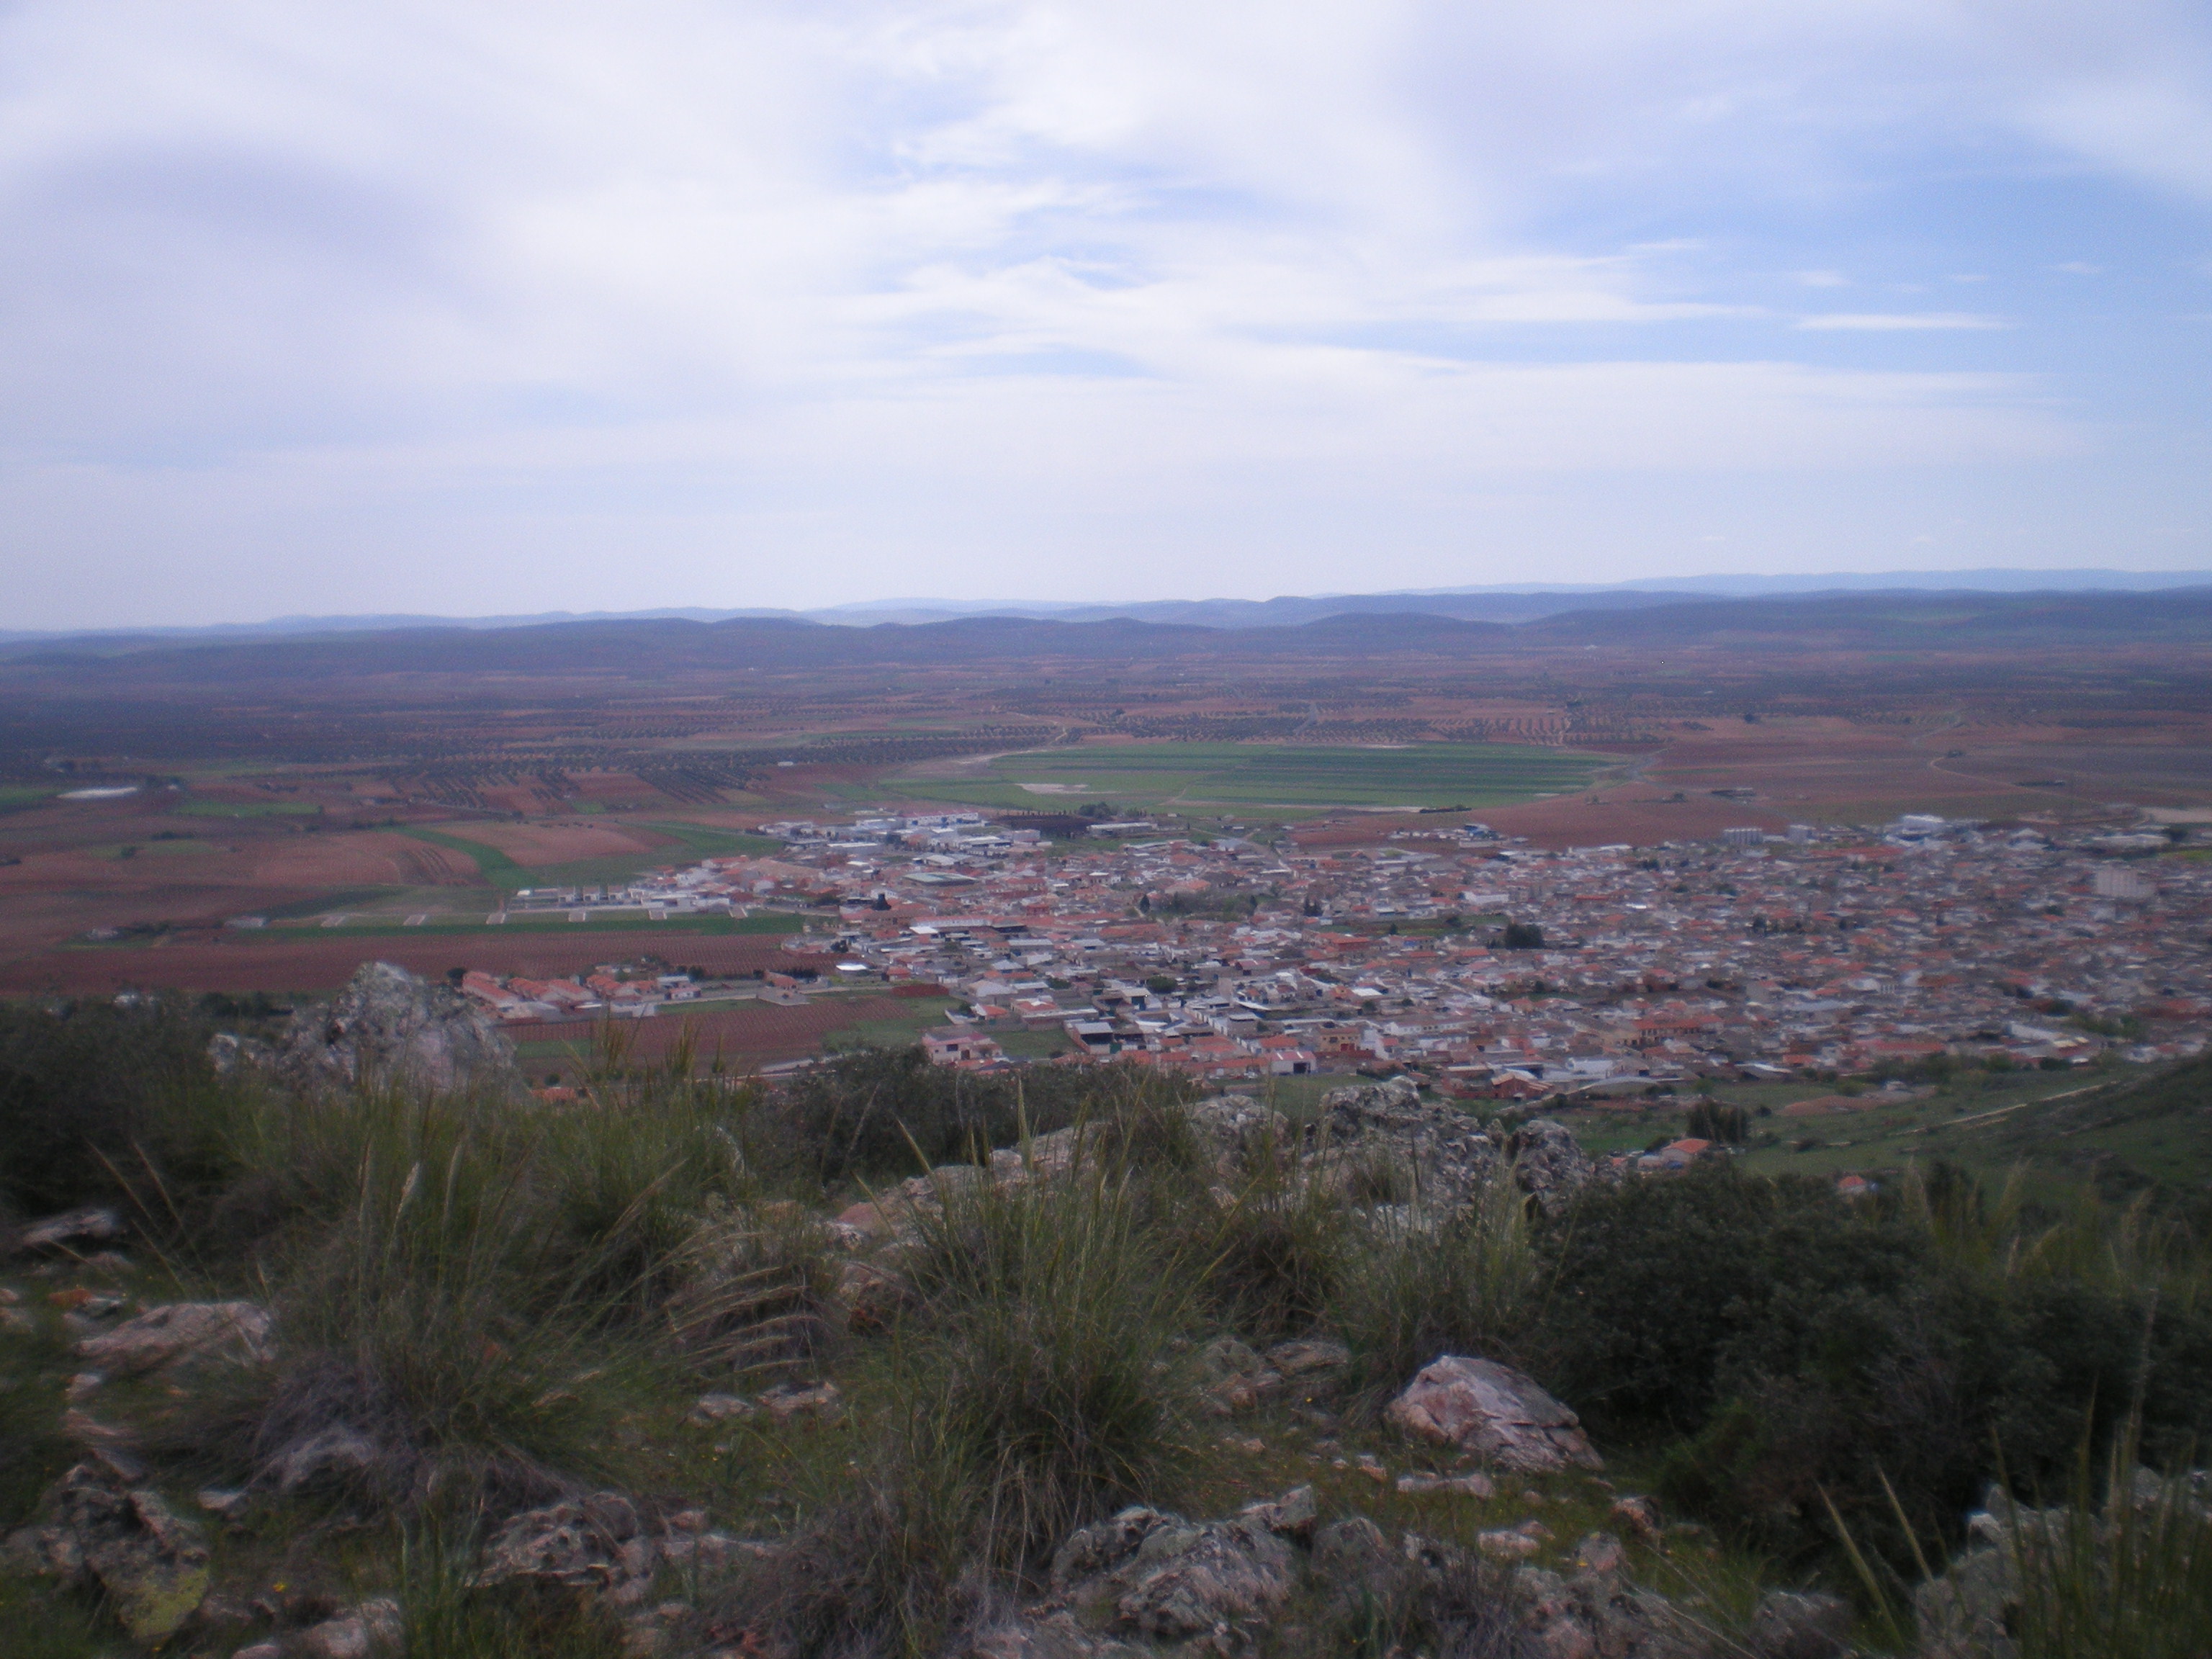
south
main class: Shrubland
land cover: Shrubland without tree cover
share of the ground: 10 - 25 %
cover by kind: herbaceous plants 50 %, consolidated bare surface 40 %, shrubs 10 %
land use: Semi-natural and natural areas not in use
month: April
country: ES
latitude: 38.8425
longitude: -3.5747
